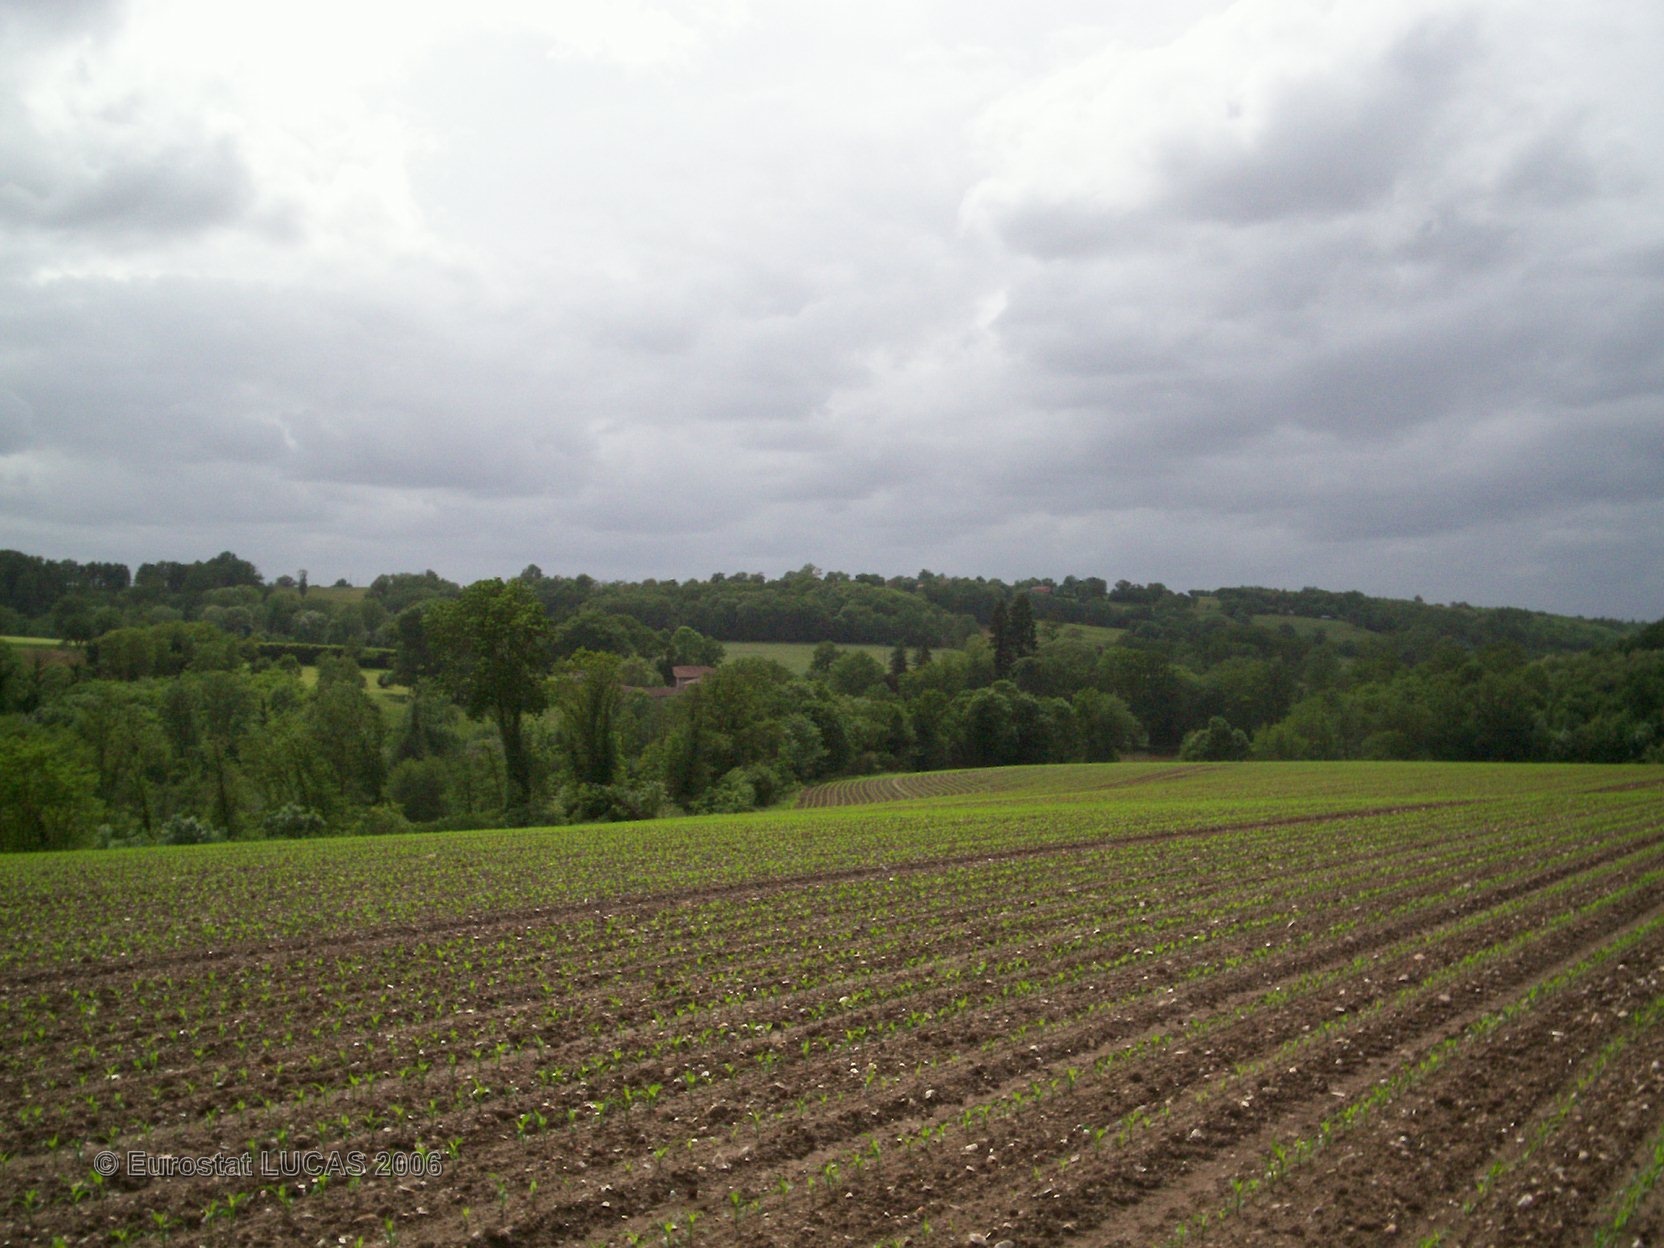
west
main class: Cropland
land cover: Maize
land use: Agriculture (excluding fallow land and kitchen gardens)
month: May
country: FR
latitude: 45.7853
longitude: 0.5318
